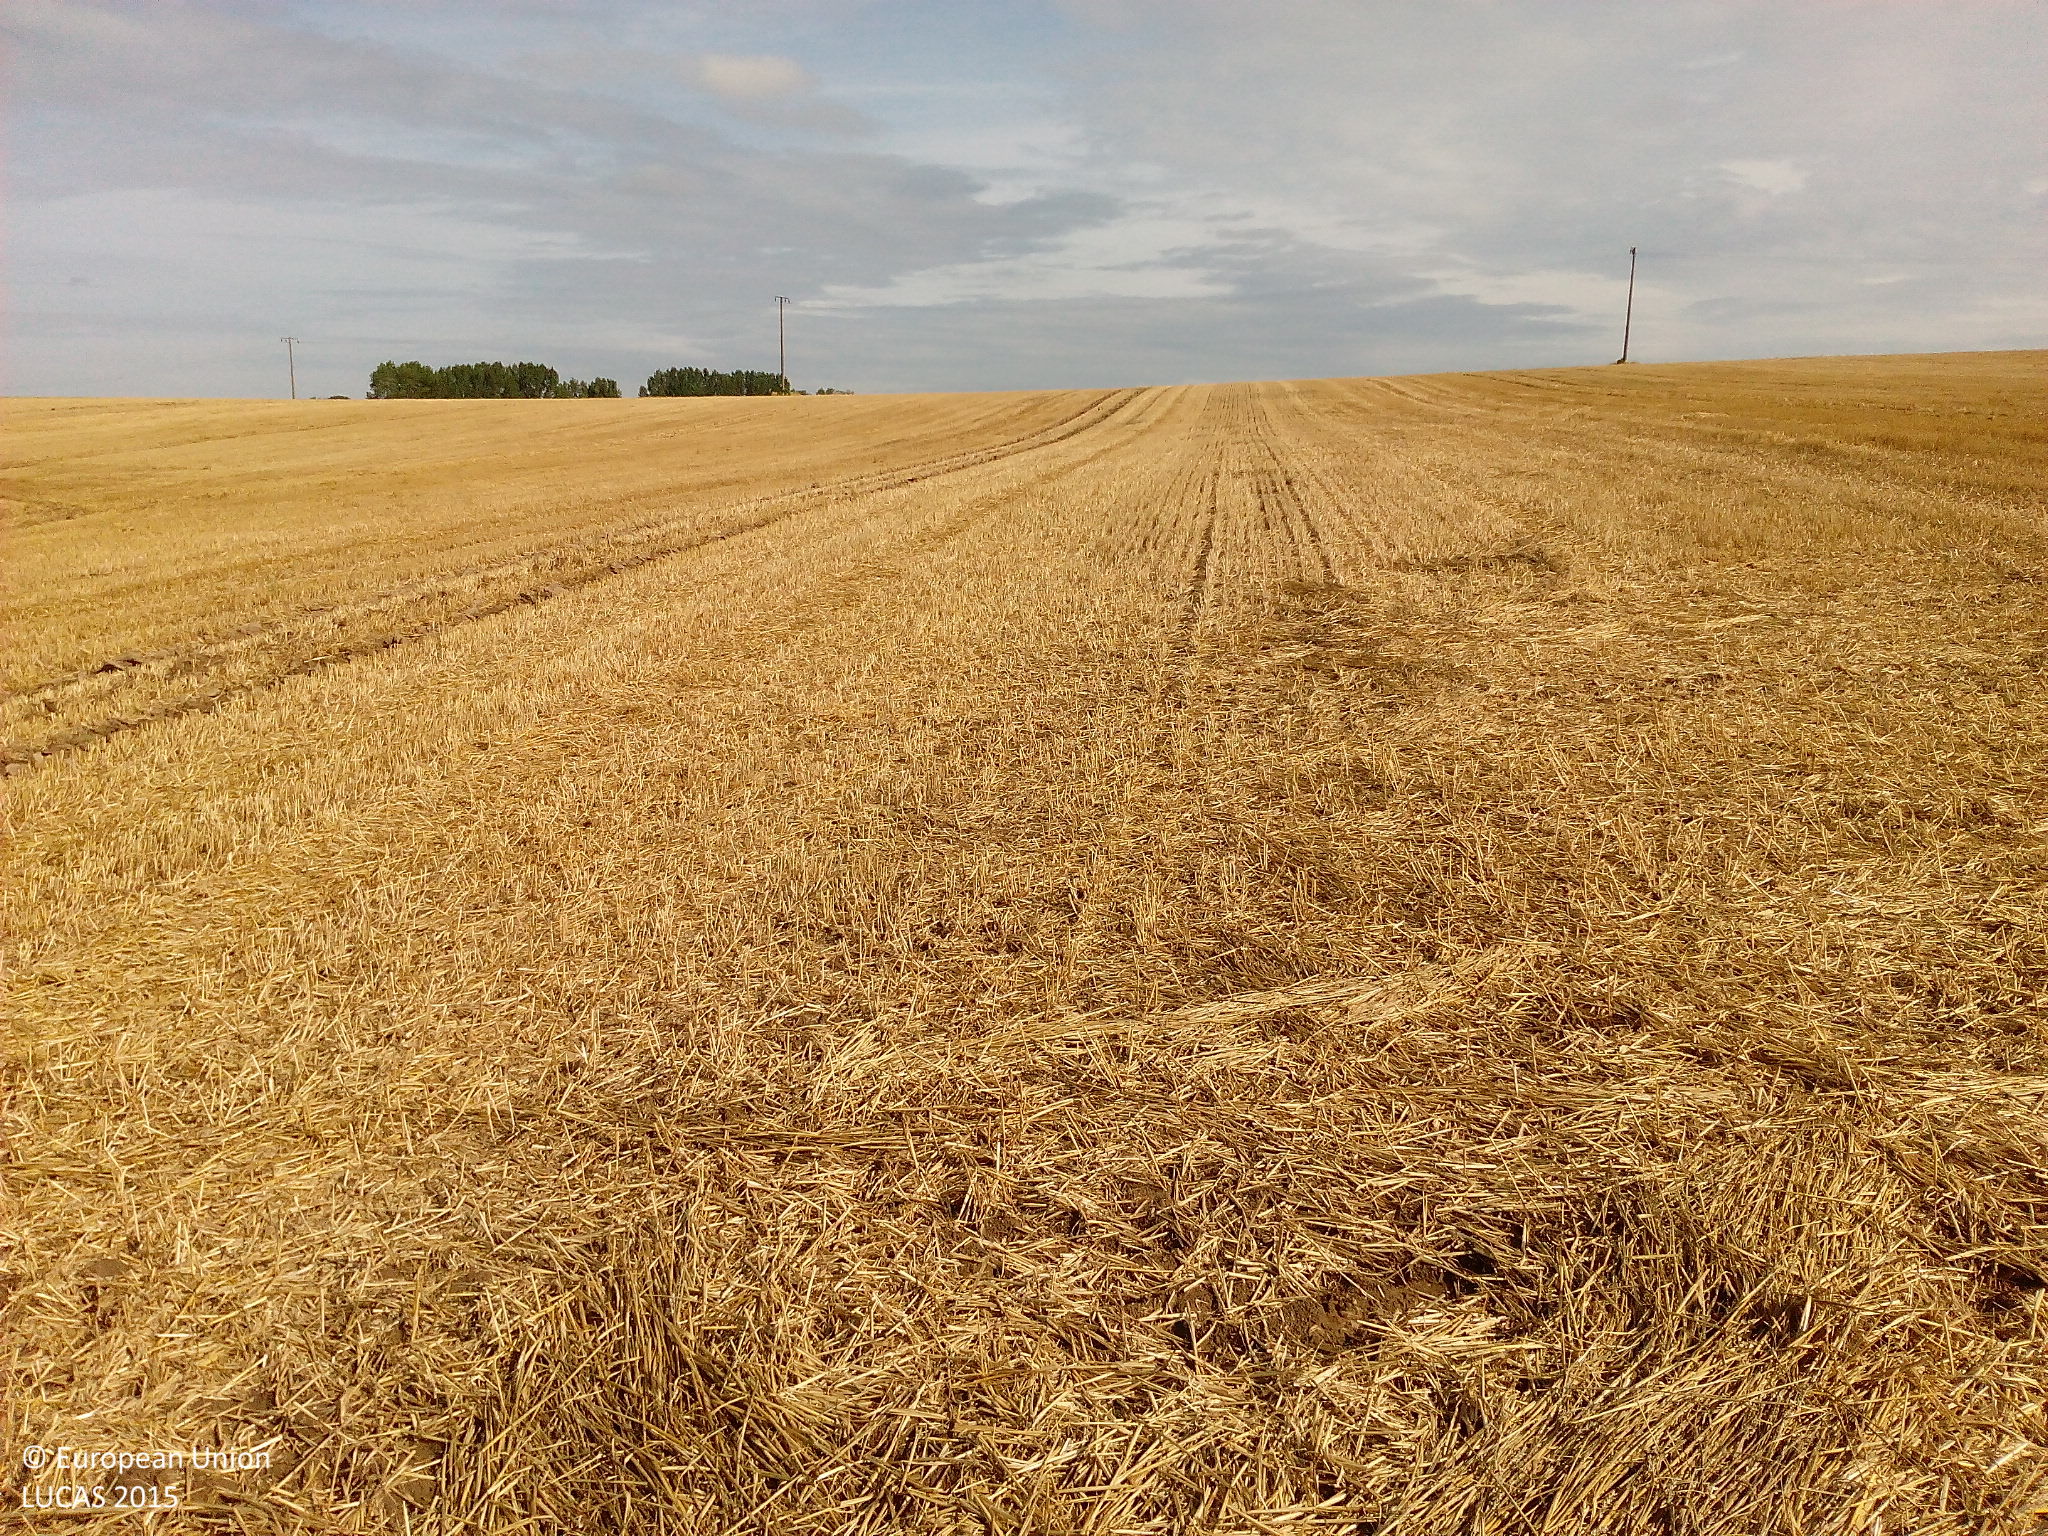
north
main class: Cropland
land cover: Common wheat
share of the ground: 50 - 75 %
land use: Agriculture (excluding fallow land and kitchen gardens)
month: August
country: DE
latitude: 53.8576
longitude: 12.6903
